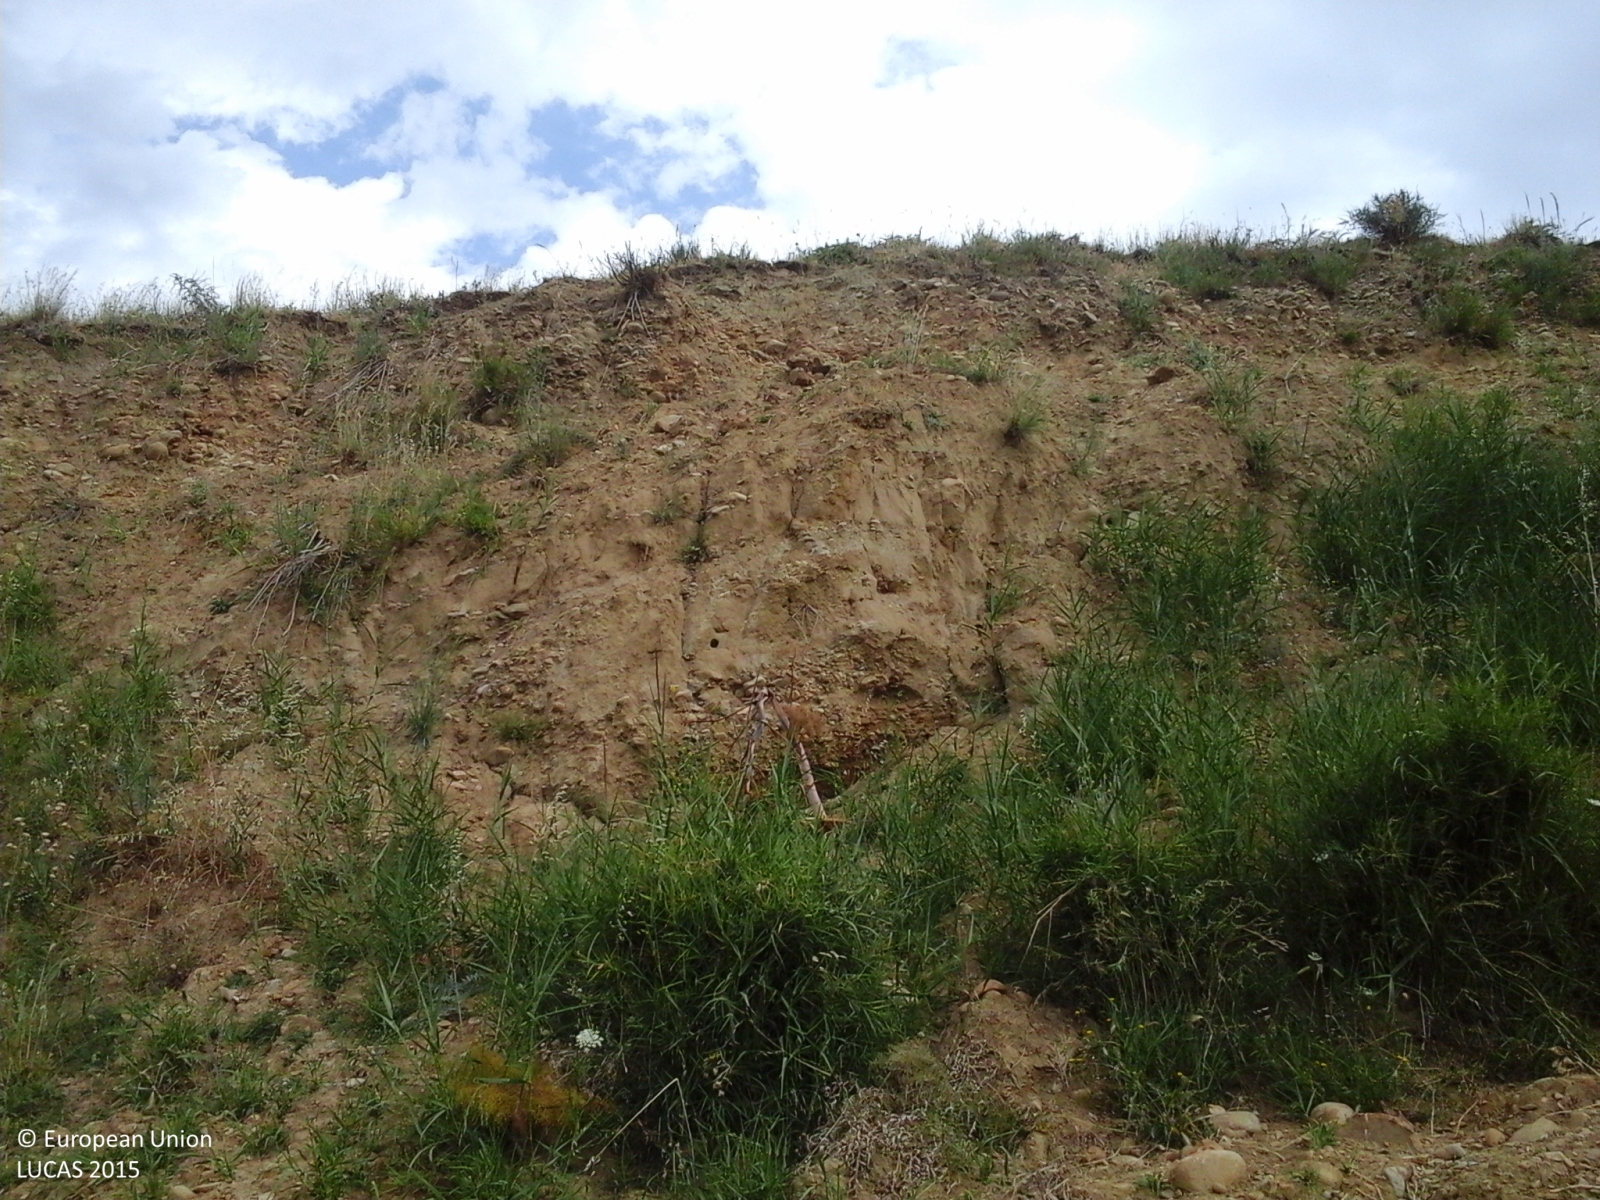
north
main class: Grassland
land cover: Grassland without tree/shrub cover
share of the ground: > 75 %
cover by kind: herbaceous plants 100 %
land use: Agriculture (excluding fallow land and kitchen gardens)
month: June
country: IT
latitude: 37.8757
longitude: 13.6912
